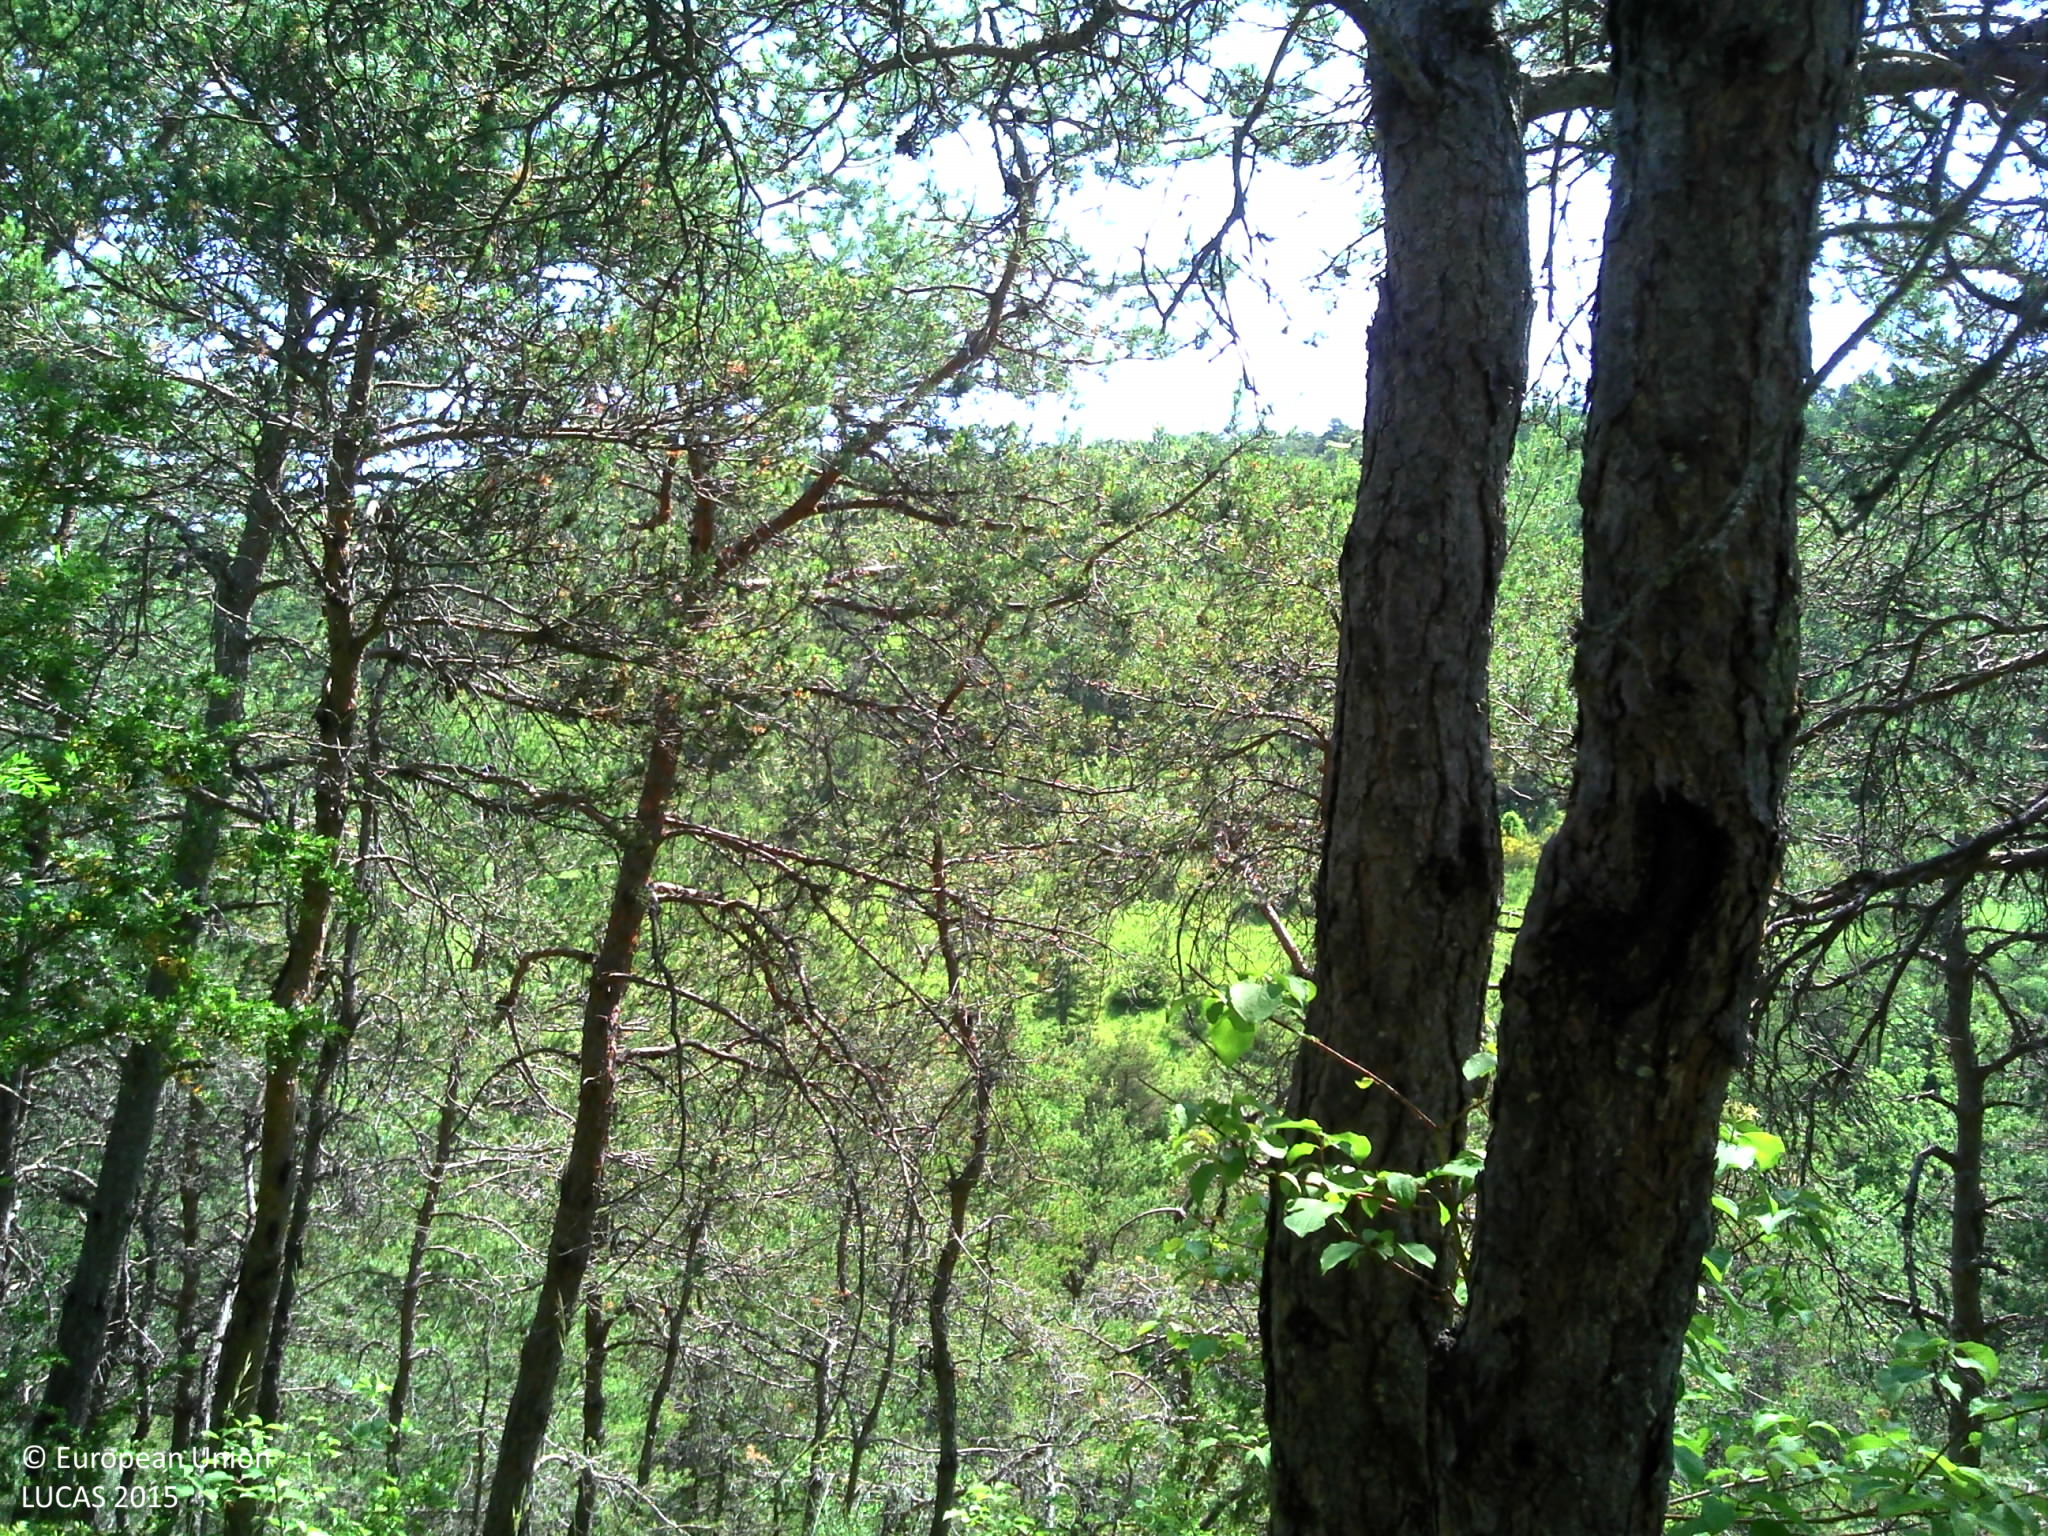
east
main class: Woodland
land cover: Pine dominated coniferous woodland
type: alpine coniferous forest
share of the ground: > 75 %
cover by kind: coniferous forest trees 100 %
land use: Agriculture (excluding fallow land and kitchen gardens)
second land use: Forestry
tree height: > 5 m
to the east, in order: Pine dominated coniferous woodland; Ditches and canals; Pine dominated coniferous woodland; Fences; Pine dominated coniferous woodland
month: June
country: FR
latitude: 44.8001
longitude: 5.2149
